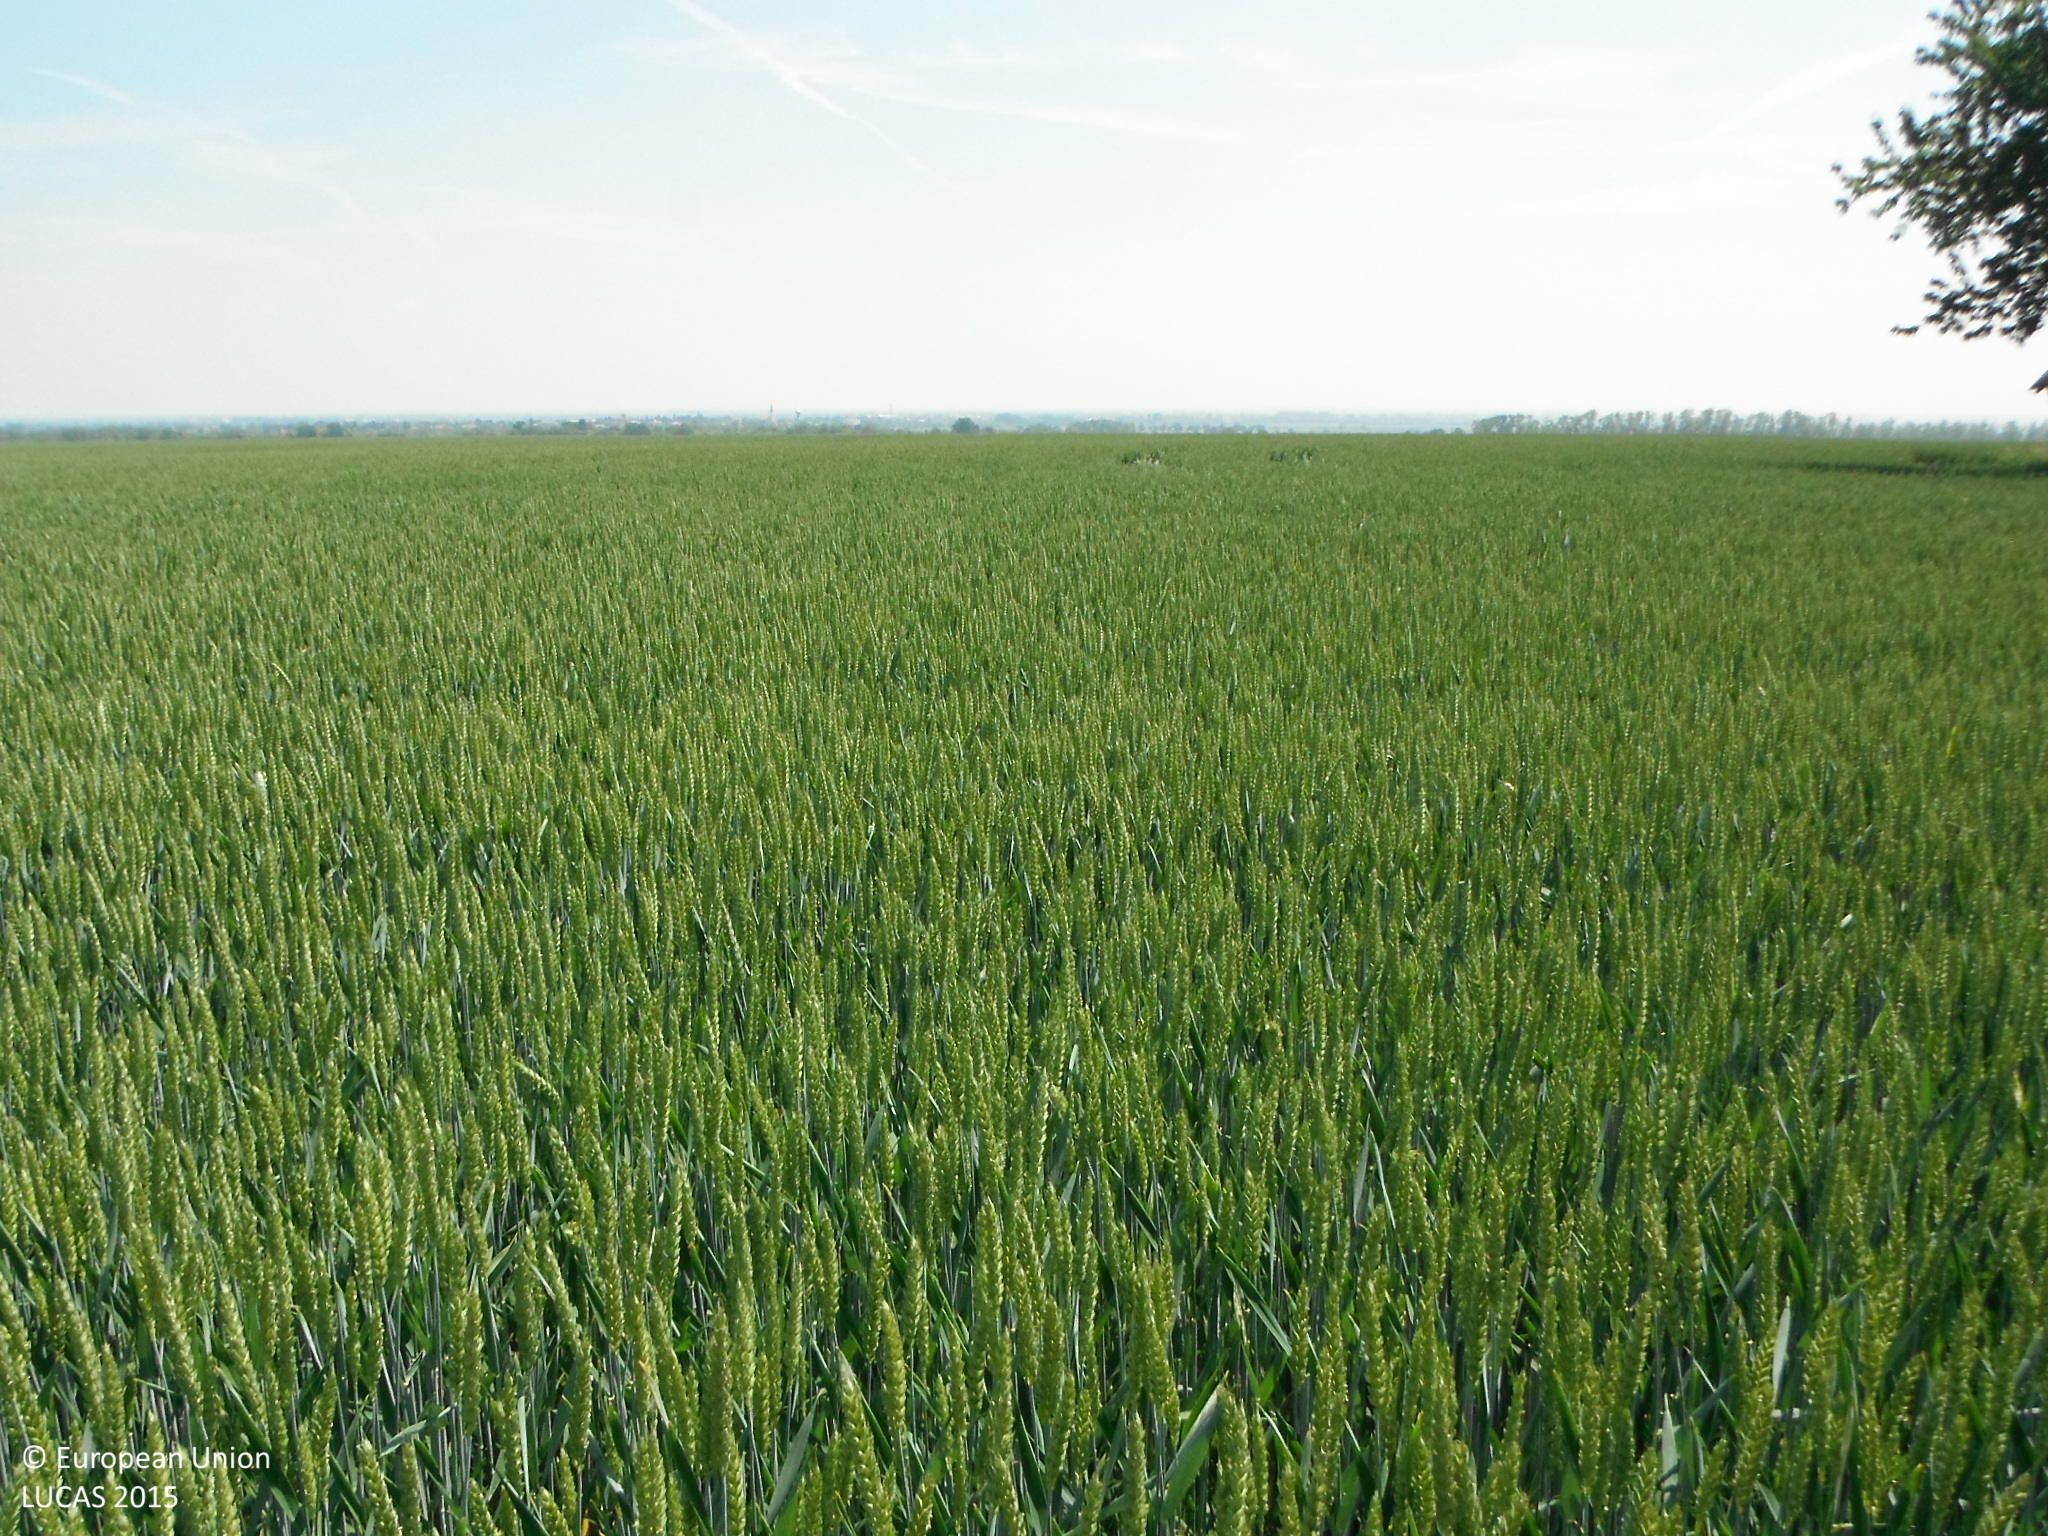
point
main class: Cropland
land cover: Common wheat
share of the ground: > 75 %
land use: Agriculture (excluding fallow land and kitchen gardens)
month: June
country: SK
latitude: 48.3171
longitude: 17.4132
